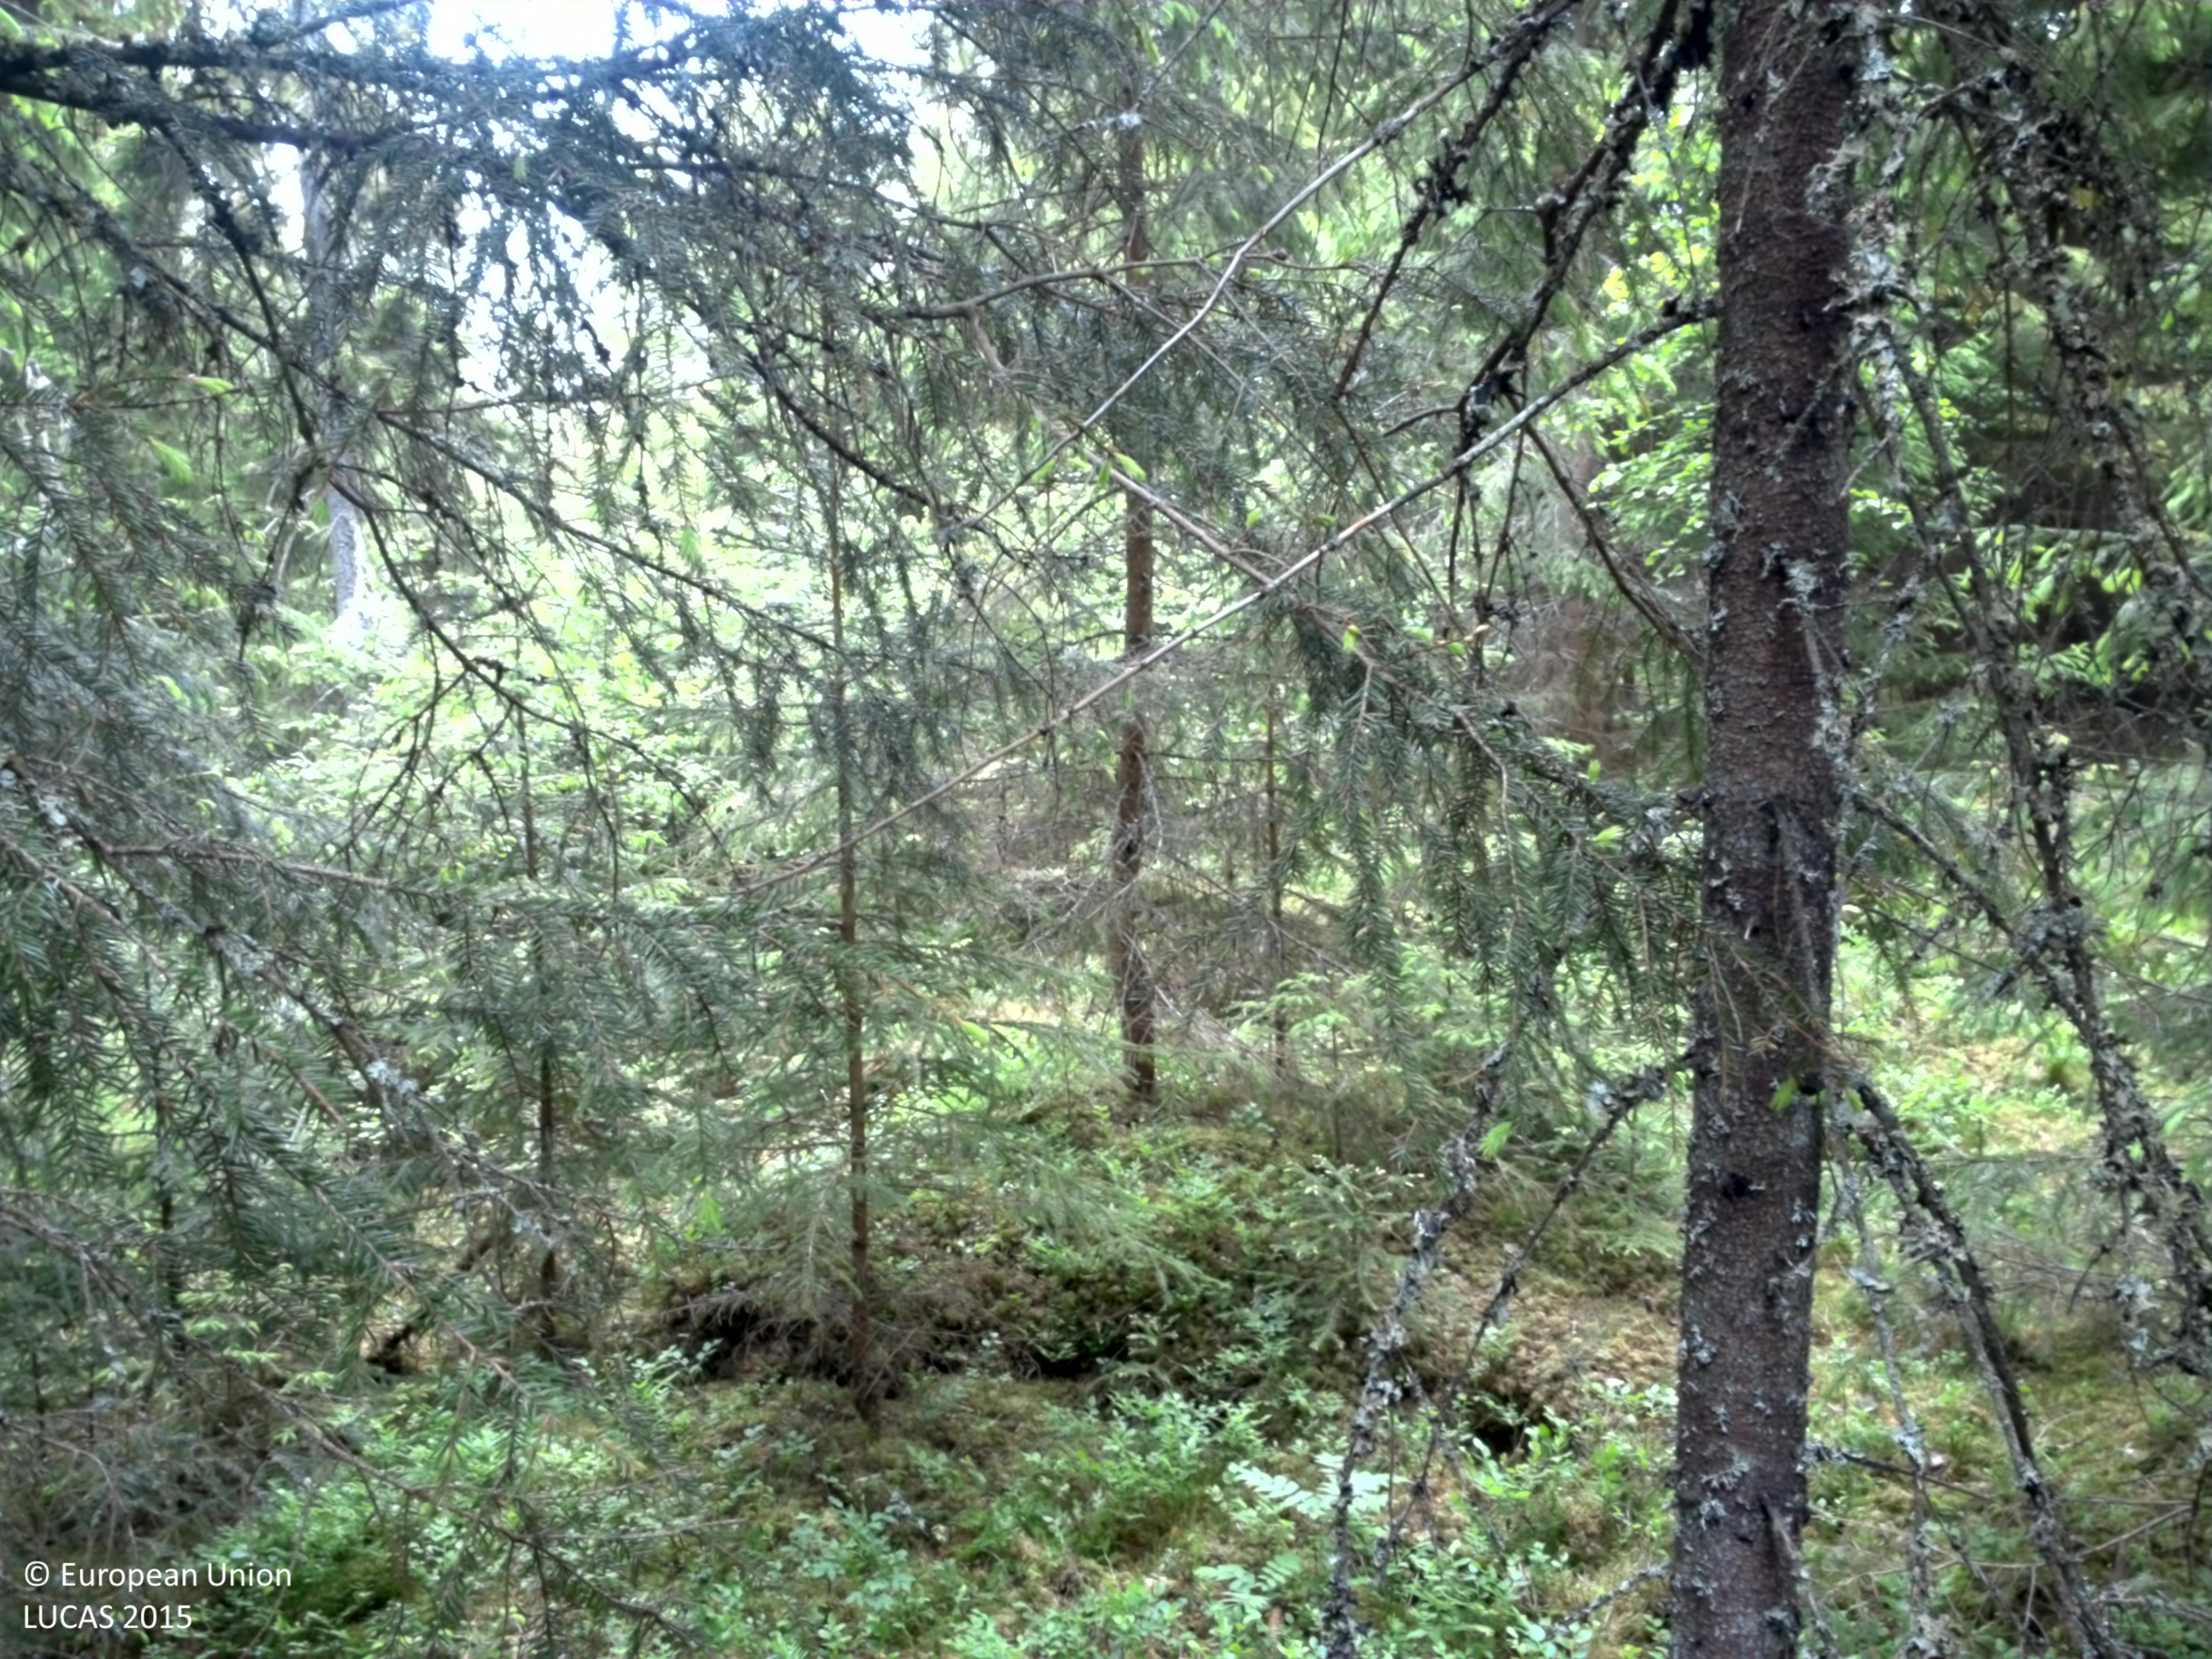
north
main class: Woodland
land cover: Spruce dominated mixed woodland
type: boreal forest
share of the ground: > 75 %
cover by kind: coniferous forest trees 55 %, broadleaved forest trees 25 %, shrubs 10 %, lichens and mosses 10 %
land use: Forestry
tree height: > 5 m
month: June
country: SE
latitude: 59.6137
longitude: 14.1914
